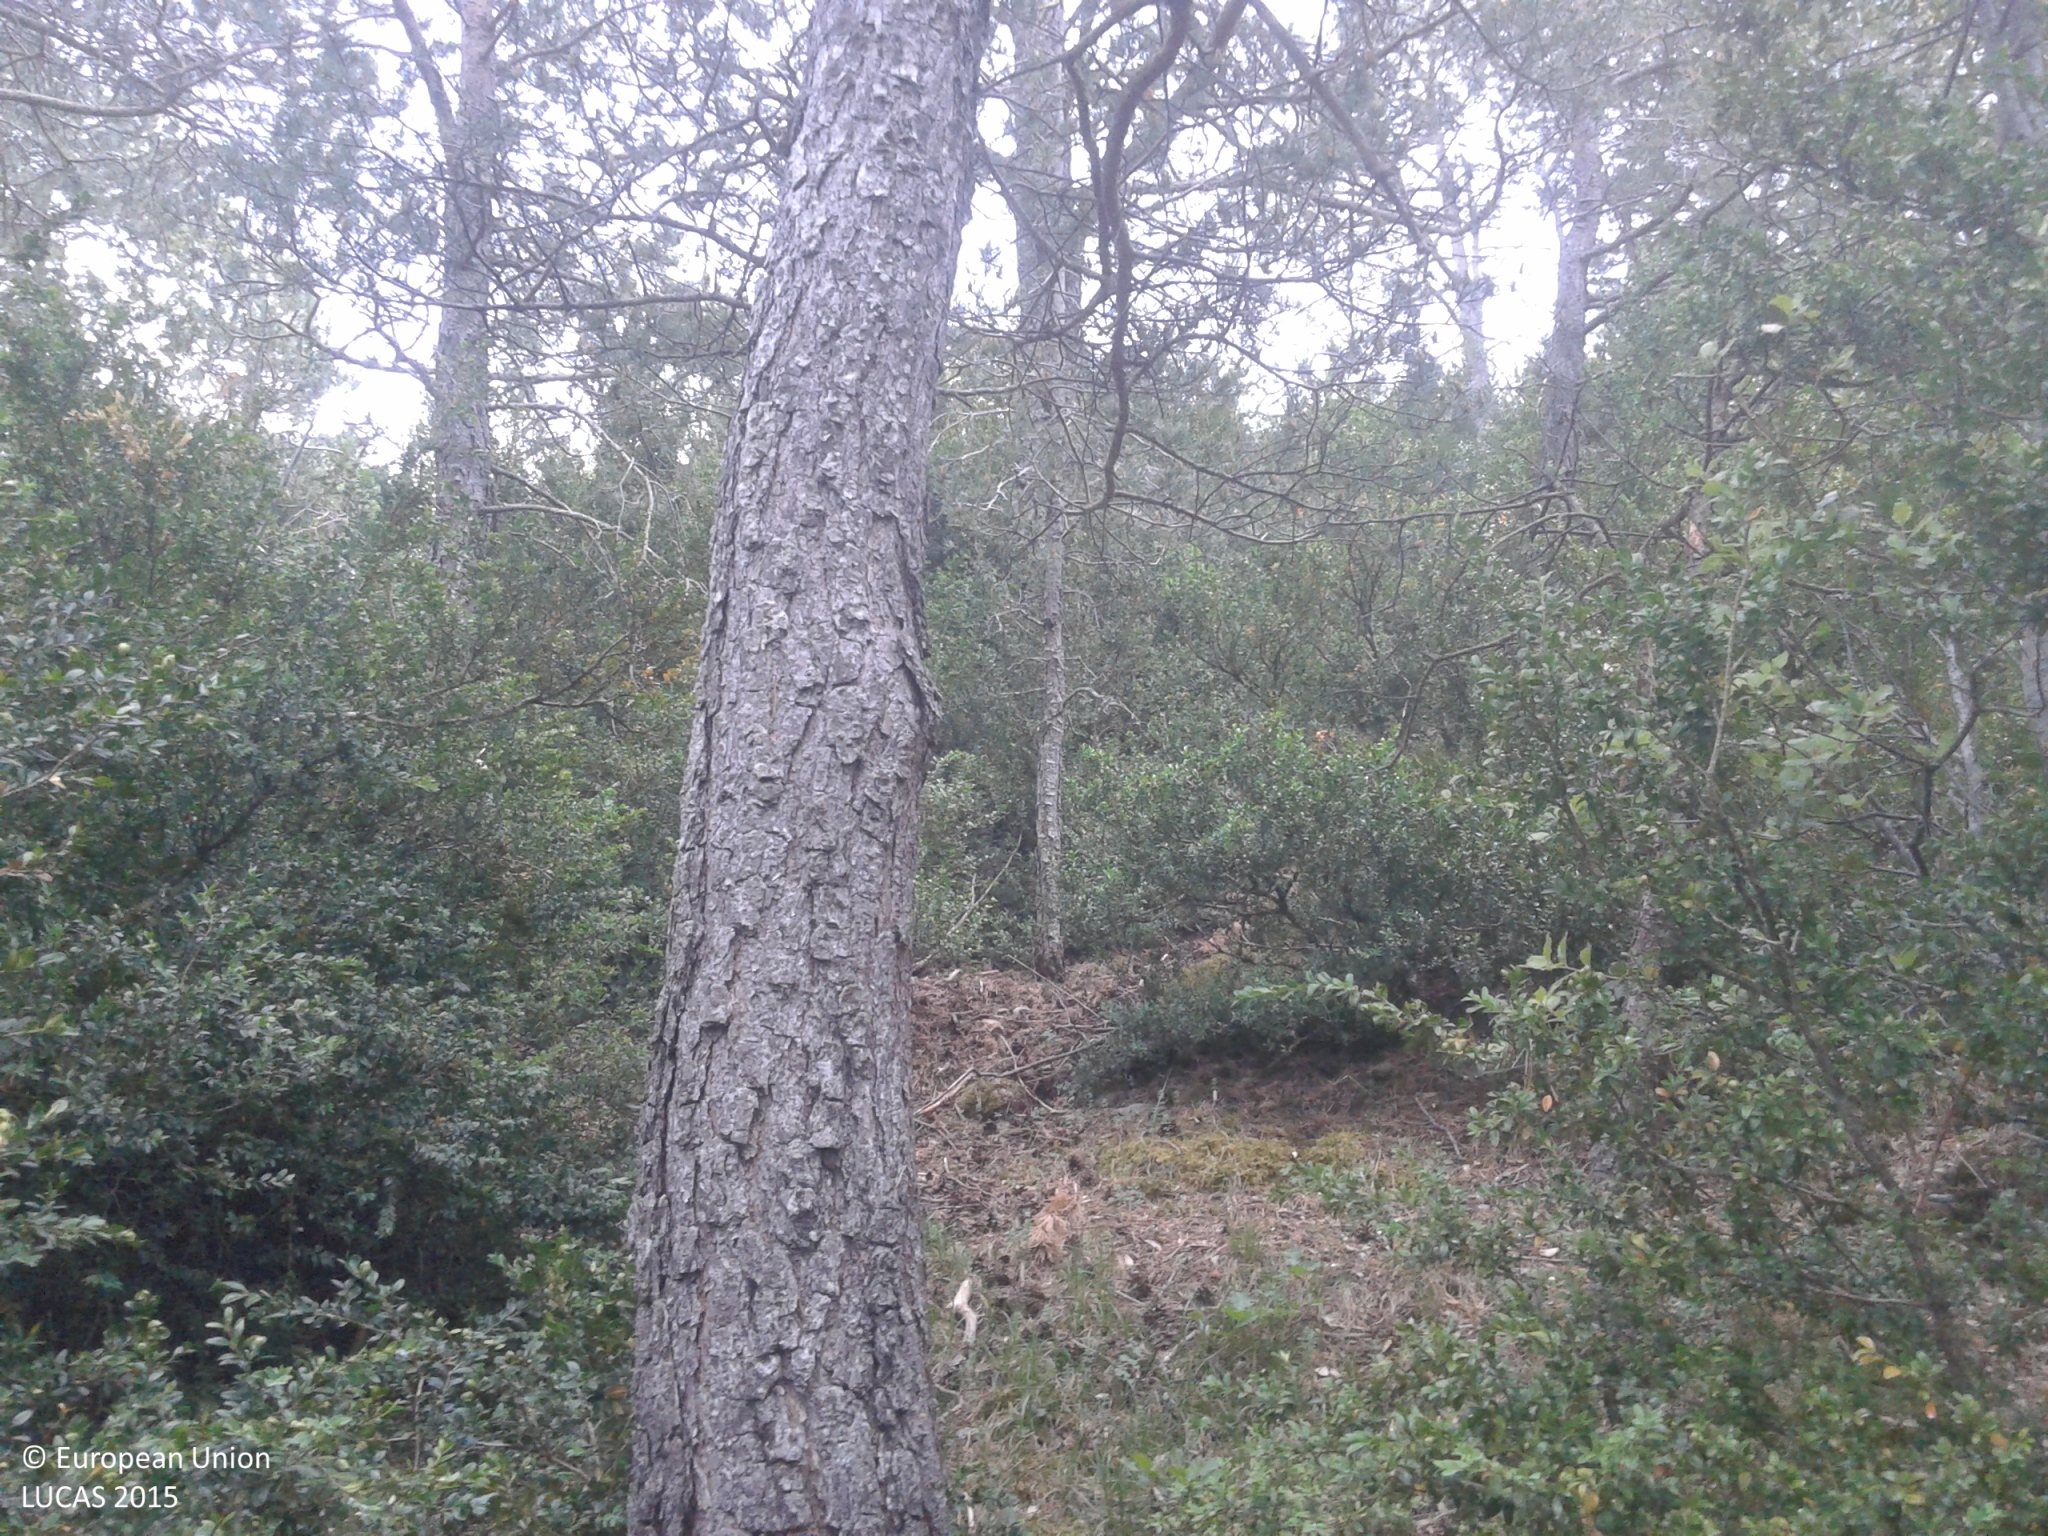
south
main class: Woodland
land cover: Pine dominated coniferous woodland
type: coniferous forest of the mediterranean region
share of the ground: 50 - 75 %
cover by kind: coniferous forest trees 70 %, shrubs 25 %, herbaceous plants 5 %
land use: Semi-natural and natural areas not in use
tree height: > 5 m
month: May
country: ES
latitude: 42.0995
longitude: 1.5357
